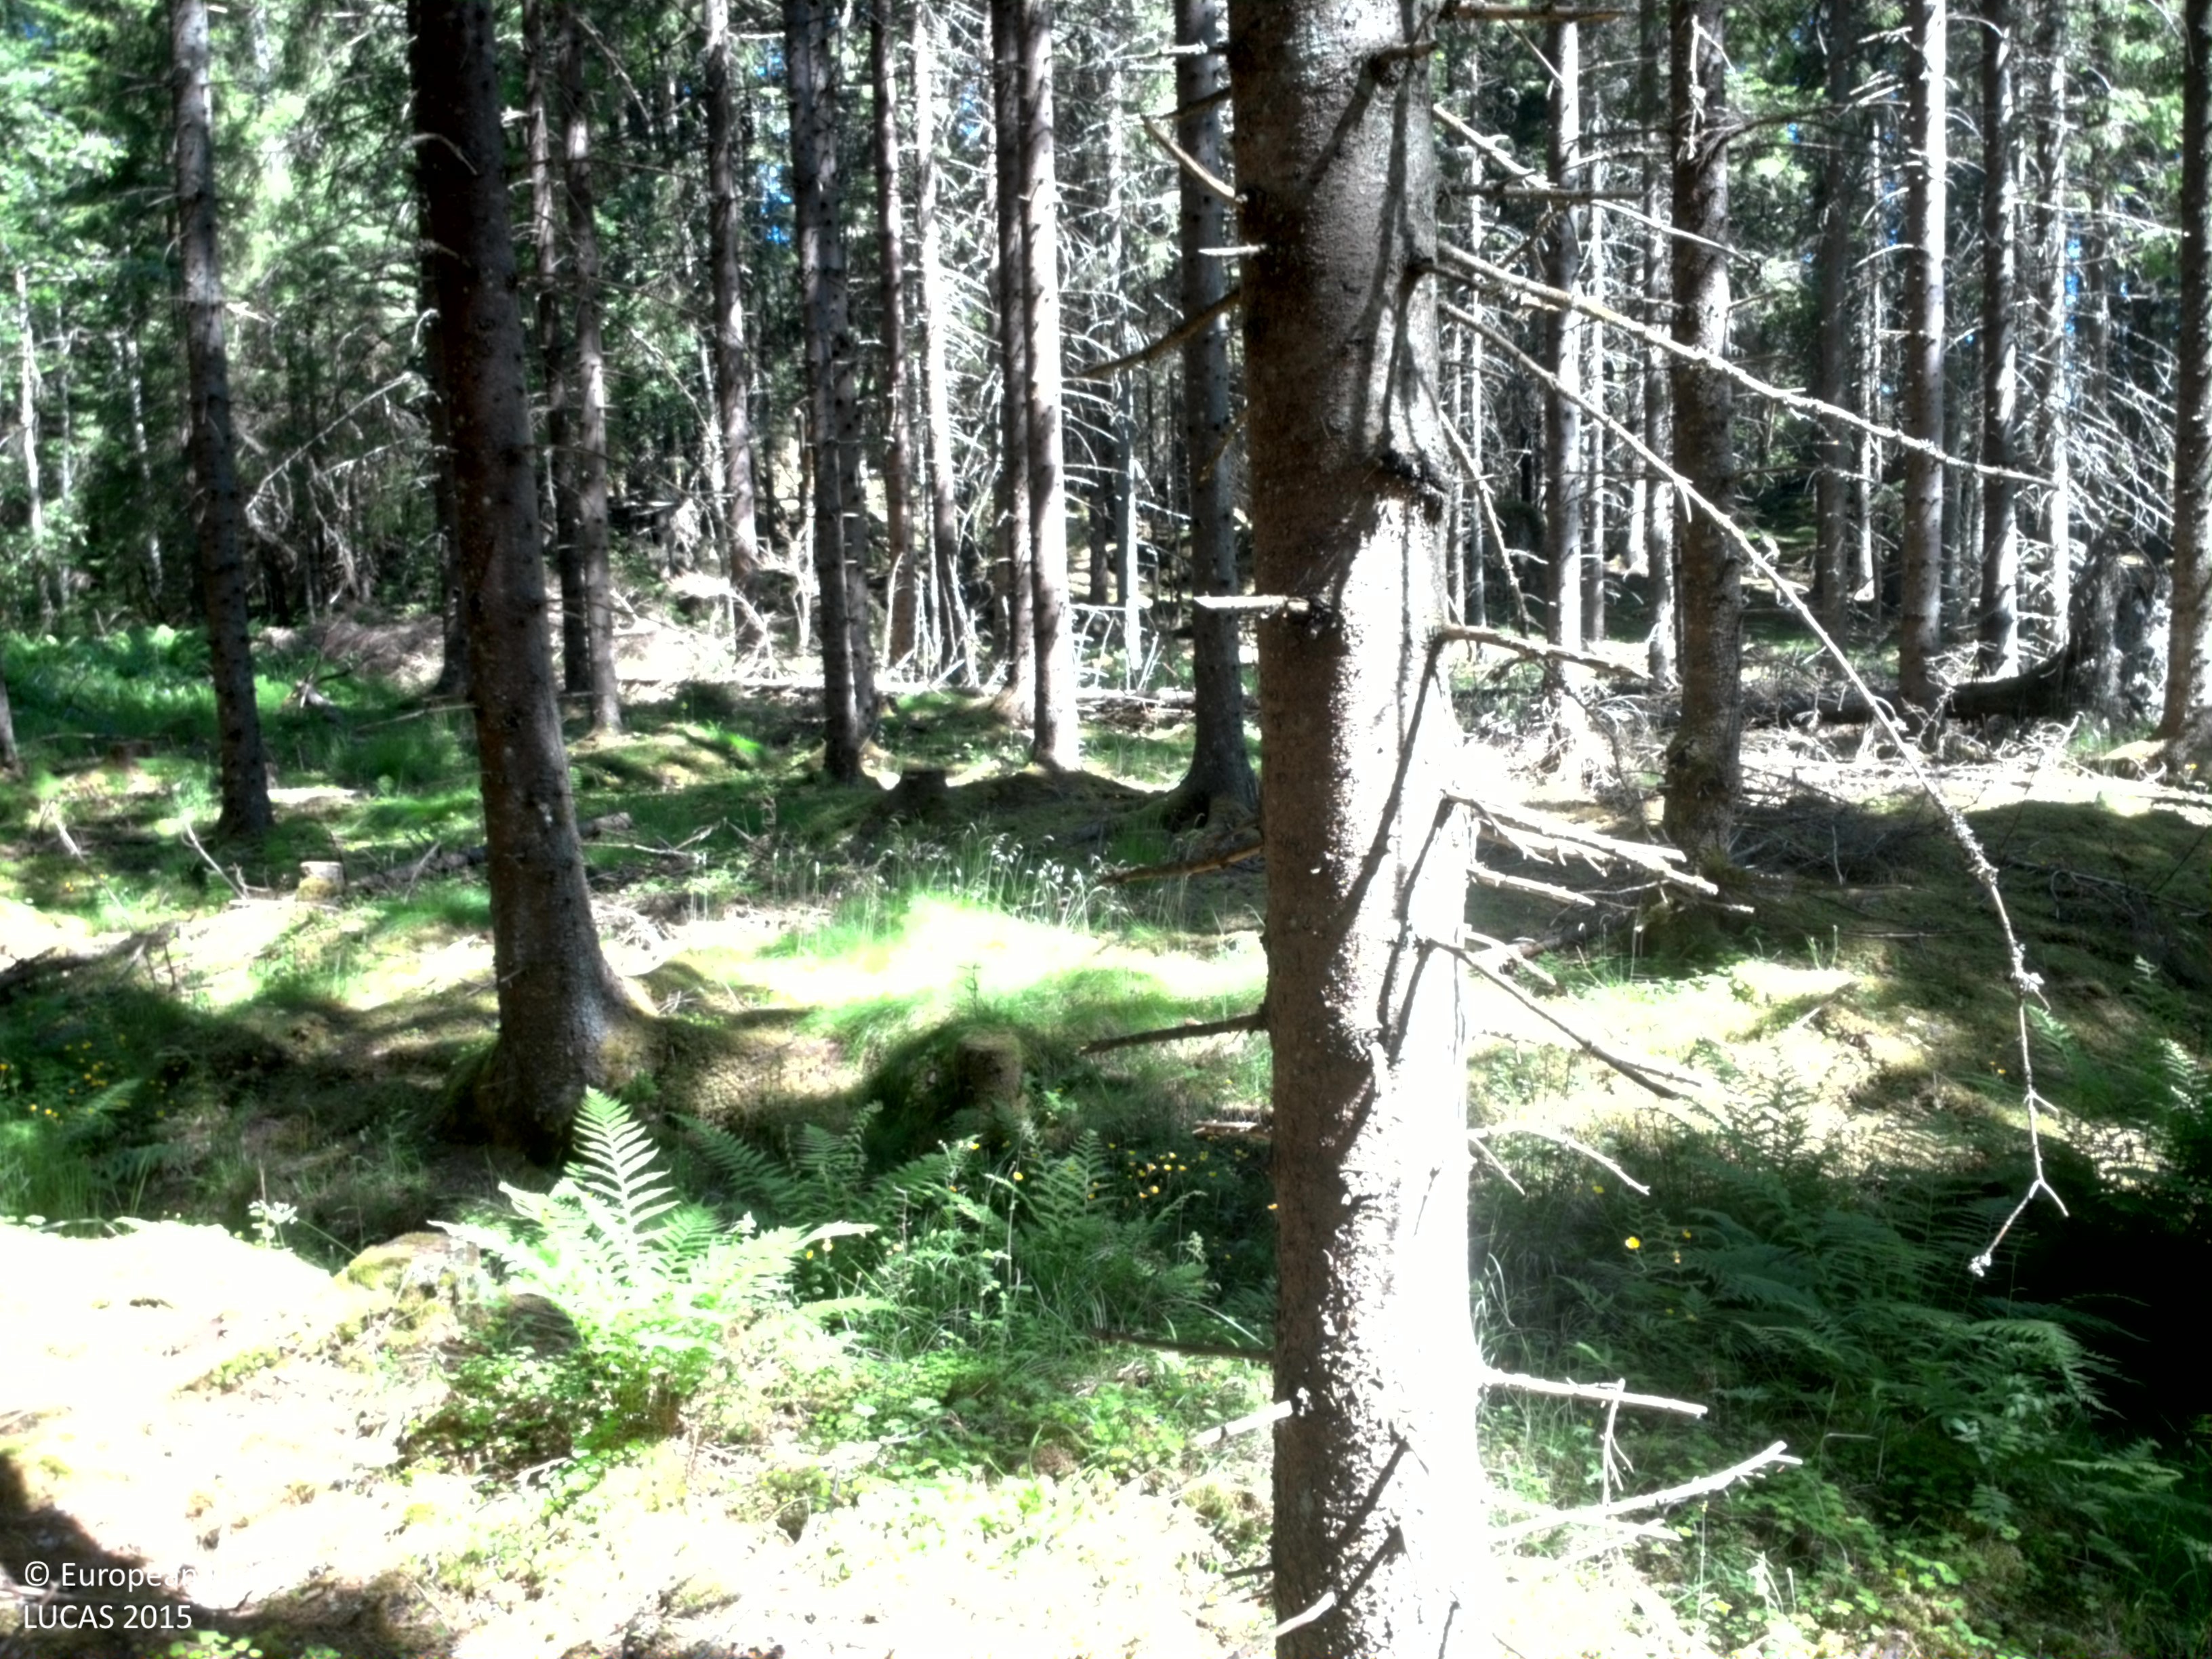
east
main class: Woodland
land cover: Spruce dominated coniferous woodland
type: boreal forest
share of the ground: 50 - 75 %
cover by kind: coniferous forest trees 70 %, lichens and mosses 15 %, broadleaved forest trees 5 %, shrubs 5 %, herbaceous plants 5 %
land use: Forestry
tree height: > 5 m
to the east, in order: Spruce dominated coniferous woodland; Ditches and canals; Spruce dominated coniferous woodland; Broadleaved woodland; Rivers and streams; Spruce dominated mixed woodland; Spruce dominated coniferous woodland
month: July
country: SE
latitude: 59.8422
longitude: 12.0108
